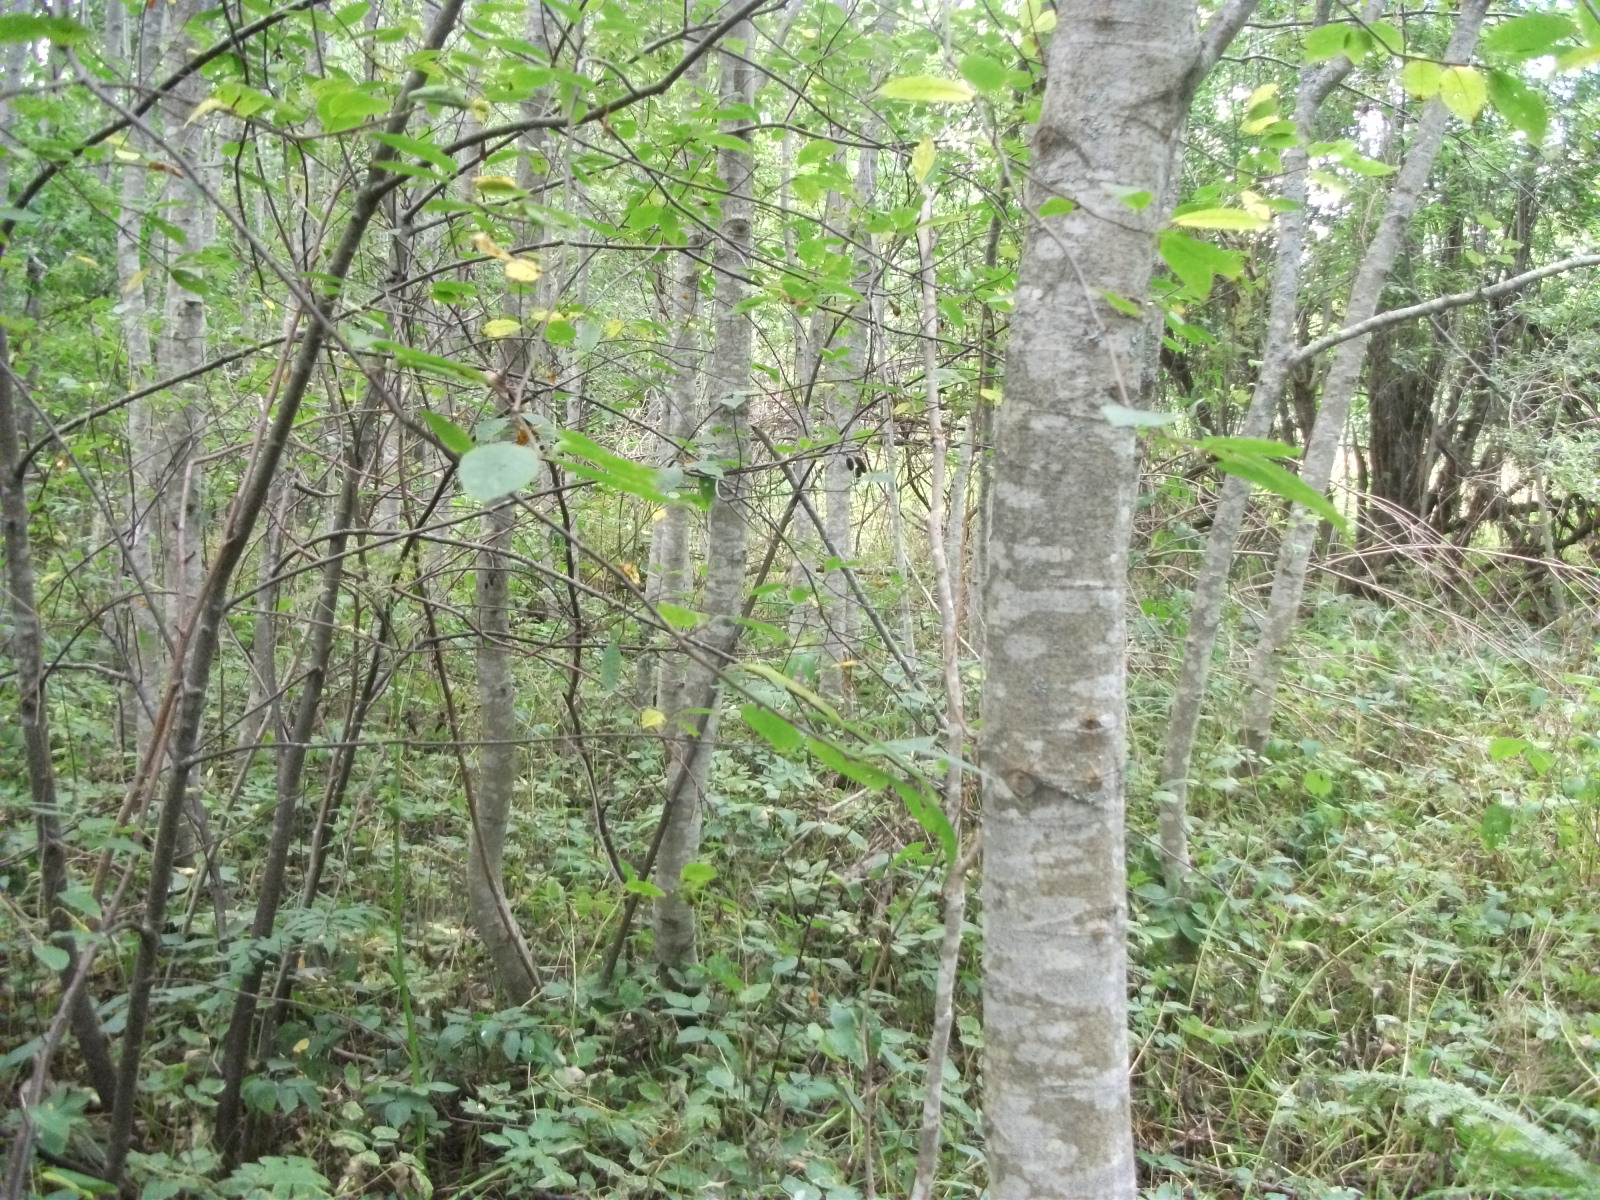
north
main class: Woodland
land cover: Broadleaved woodland
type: non-riverine alder, birch or aspen forest
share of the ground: > 75 %
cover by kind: broadleaved forest trees 85 %, shrubs 10 %, herbaceous plants 5 %
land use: Forestry
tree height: > 5 m
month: August
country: LV
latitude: 56.5960
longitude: 26.3816
